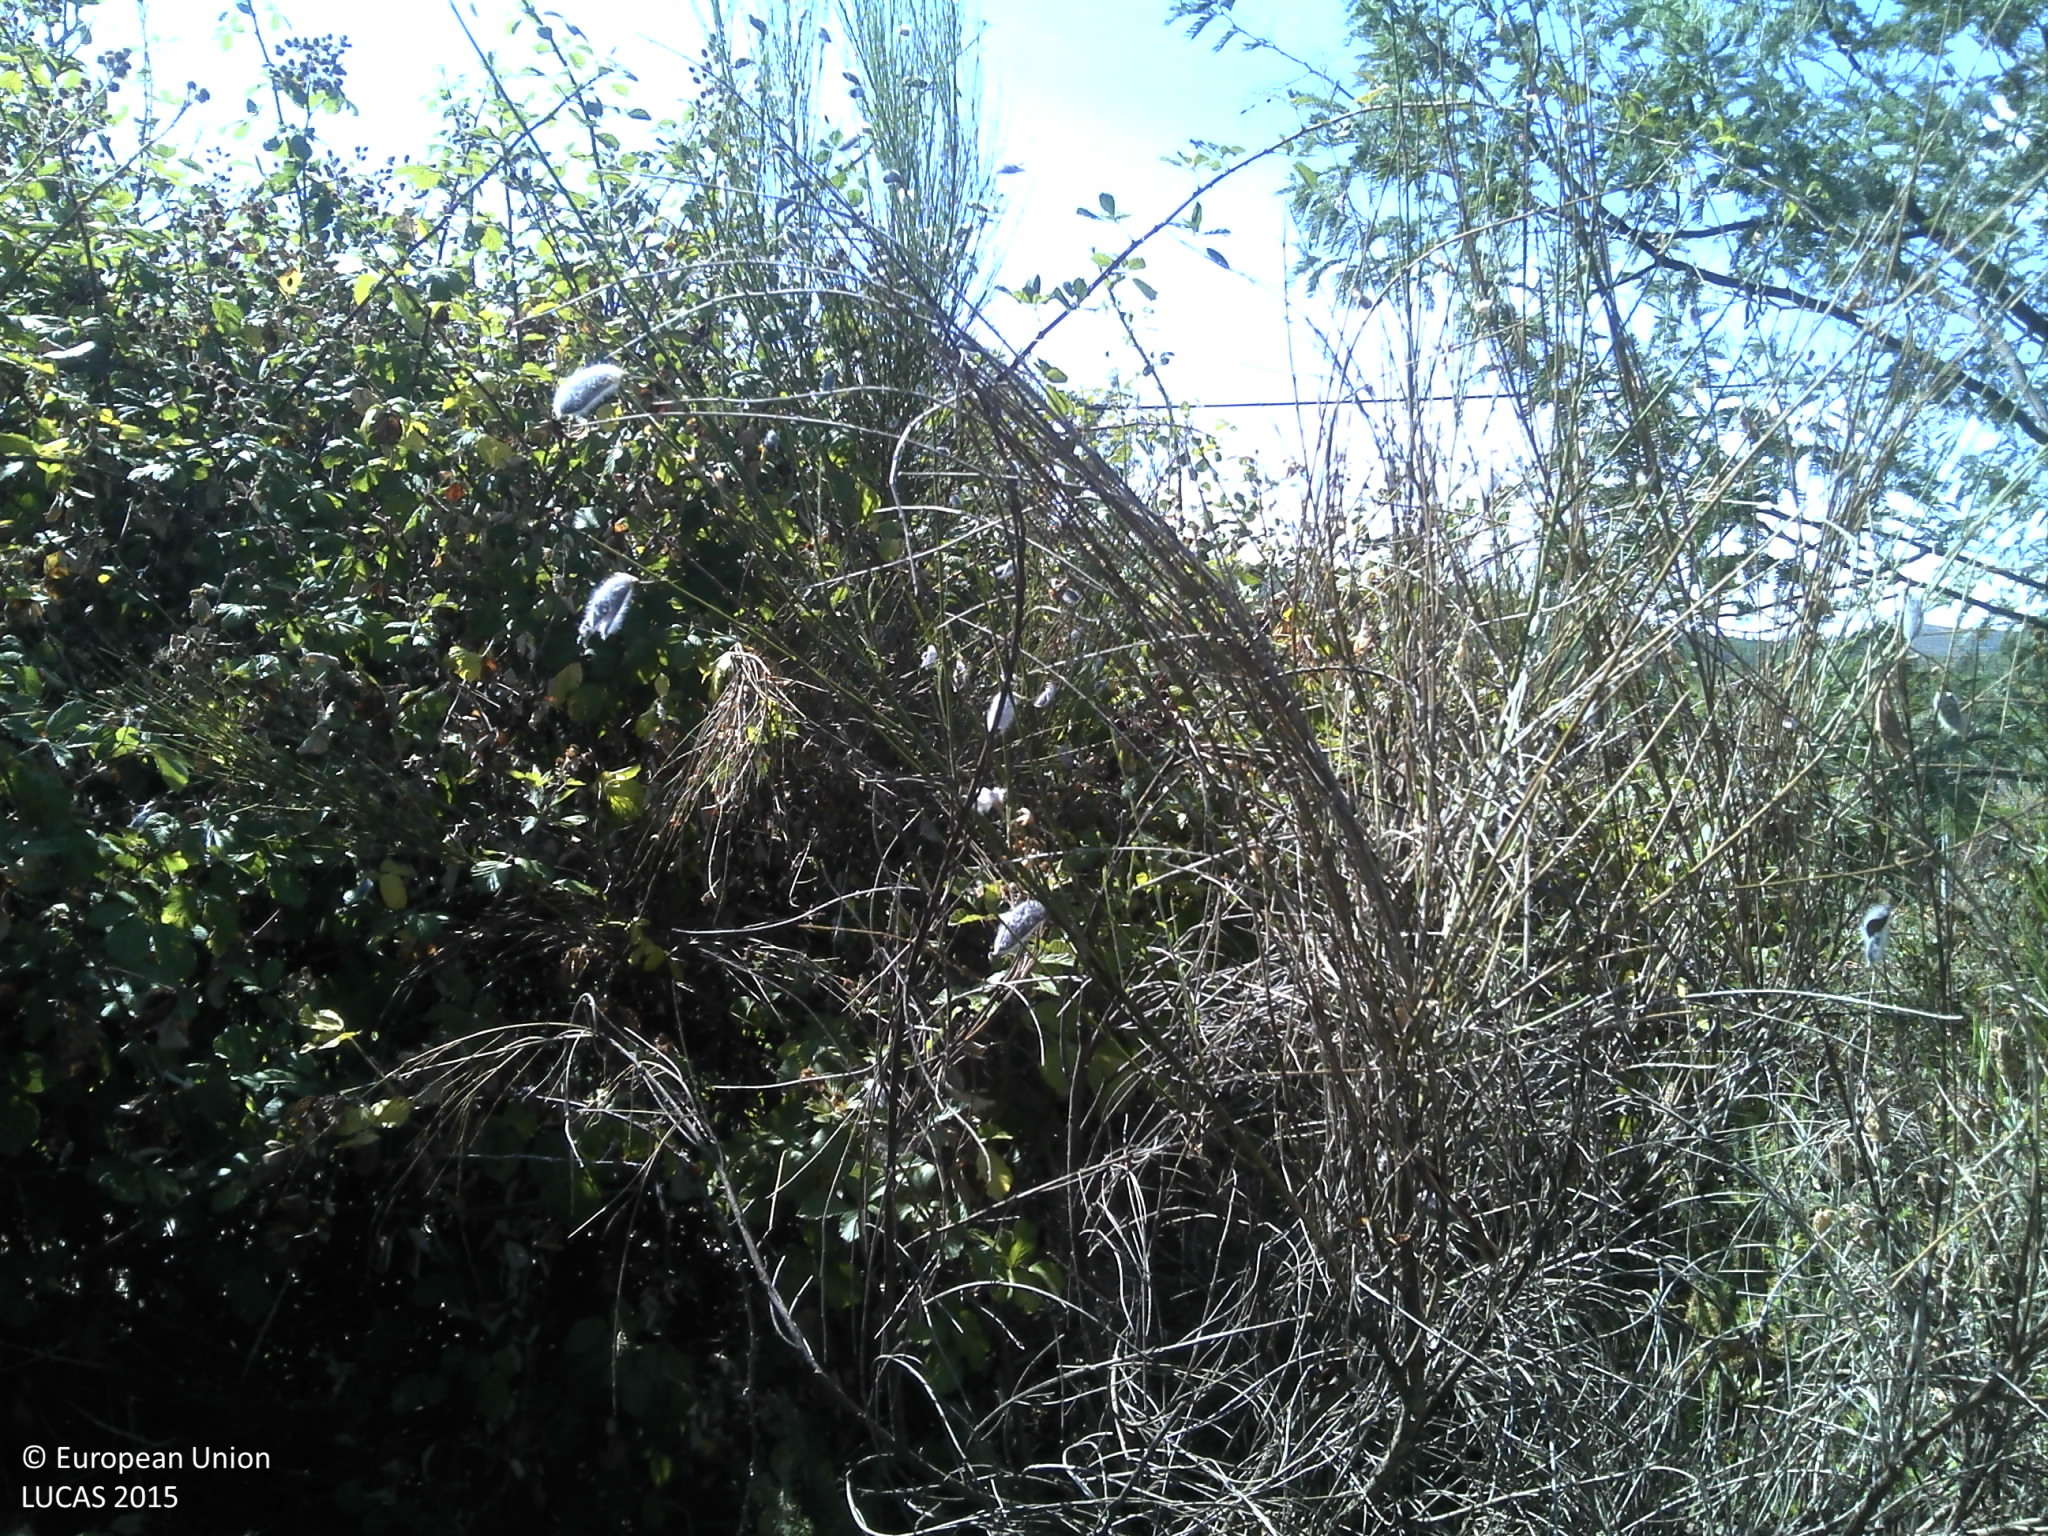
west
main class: Shrubland
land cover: Shrubland with sparse tree cover
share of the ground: > 75 %
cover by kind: shrubs 85 %, unconsolidated bare surface 10 %, coniferous forest trees 5 %
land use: Semi-natural and natural areas not in use
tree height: > 5 m
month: July
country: PT
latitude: 40.0873
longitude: -7.8818
